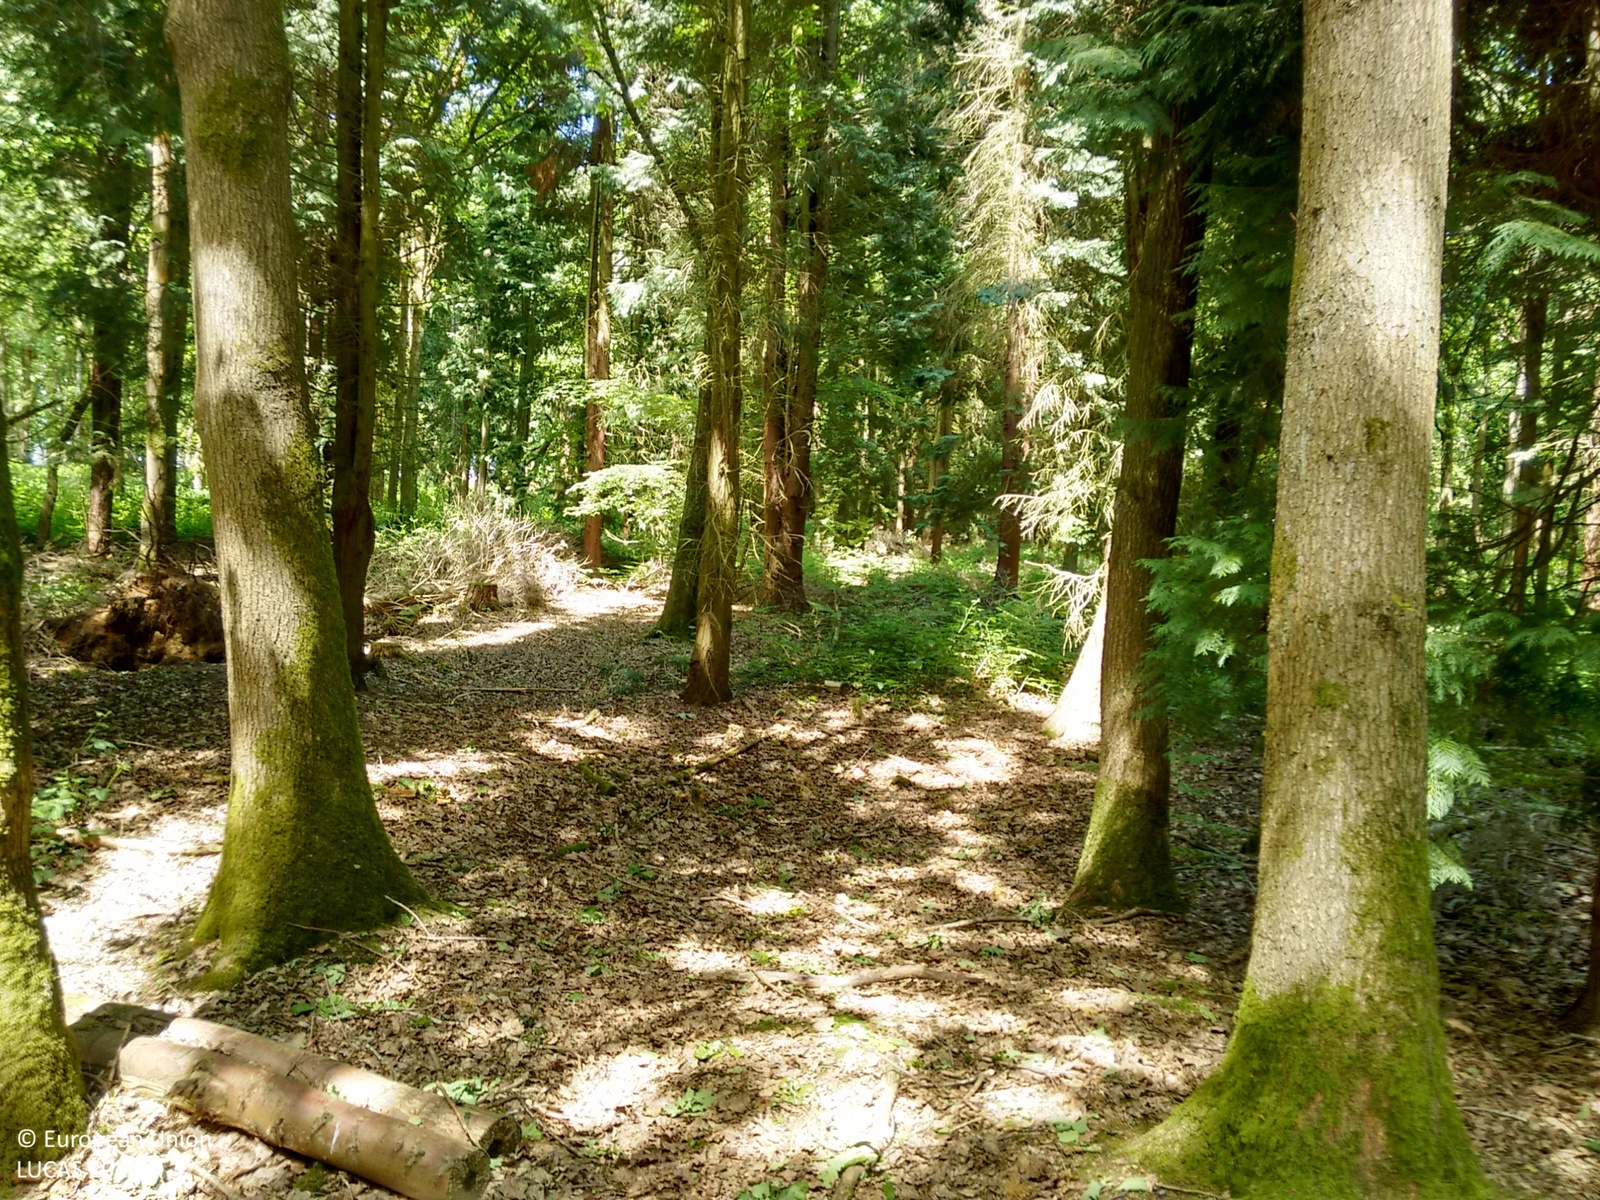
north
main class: Woodland
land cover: Other mixed woodland
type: exotic forest
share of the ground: > 75 %
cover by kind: broadleaved forest trees 50 %, coniferous forest trees 40 %, herbaceous plants 10 %
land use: Forestry
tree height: > 5 m
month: June
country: GB
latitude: 51.8379
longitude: -0.2969
